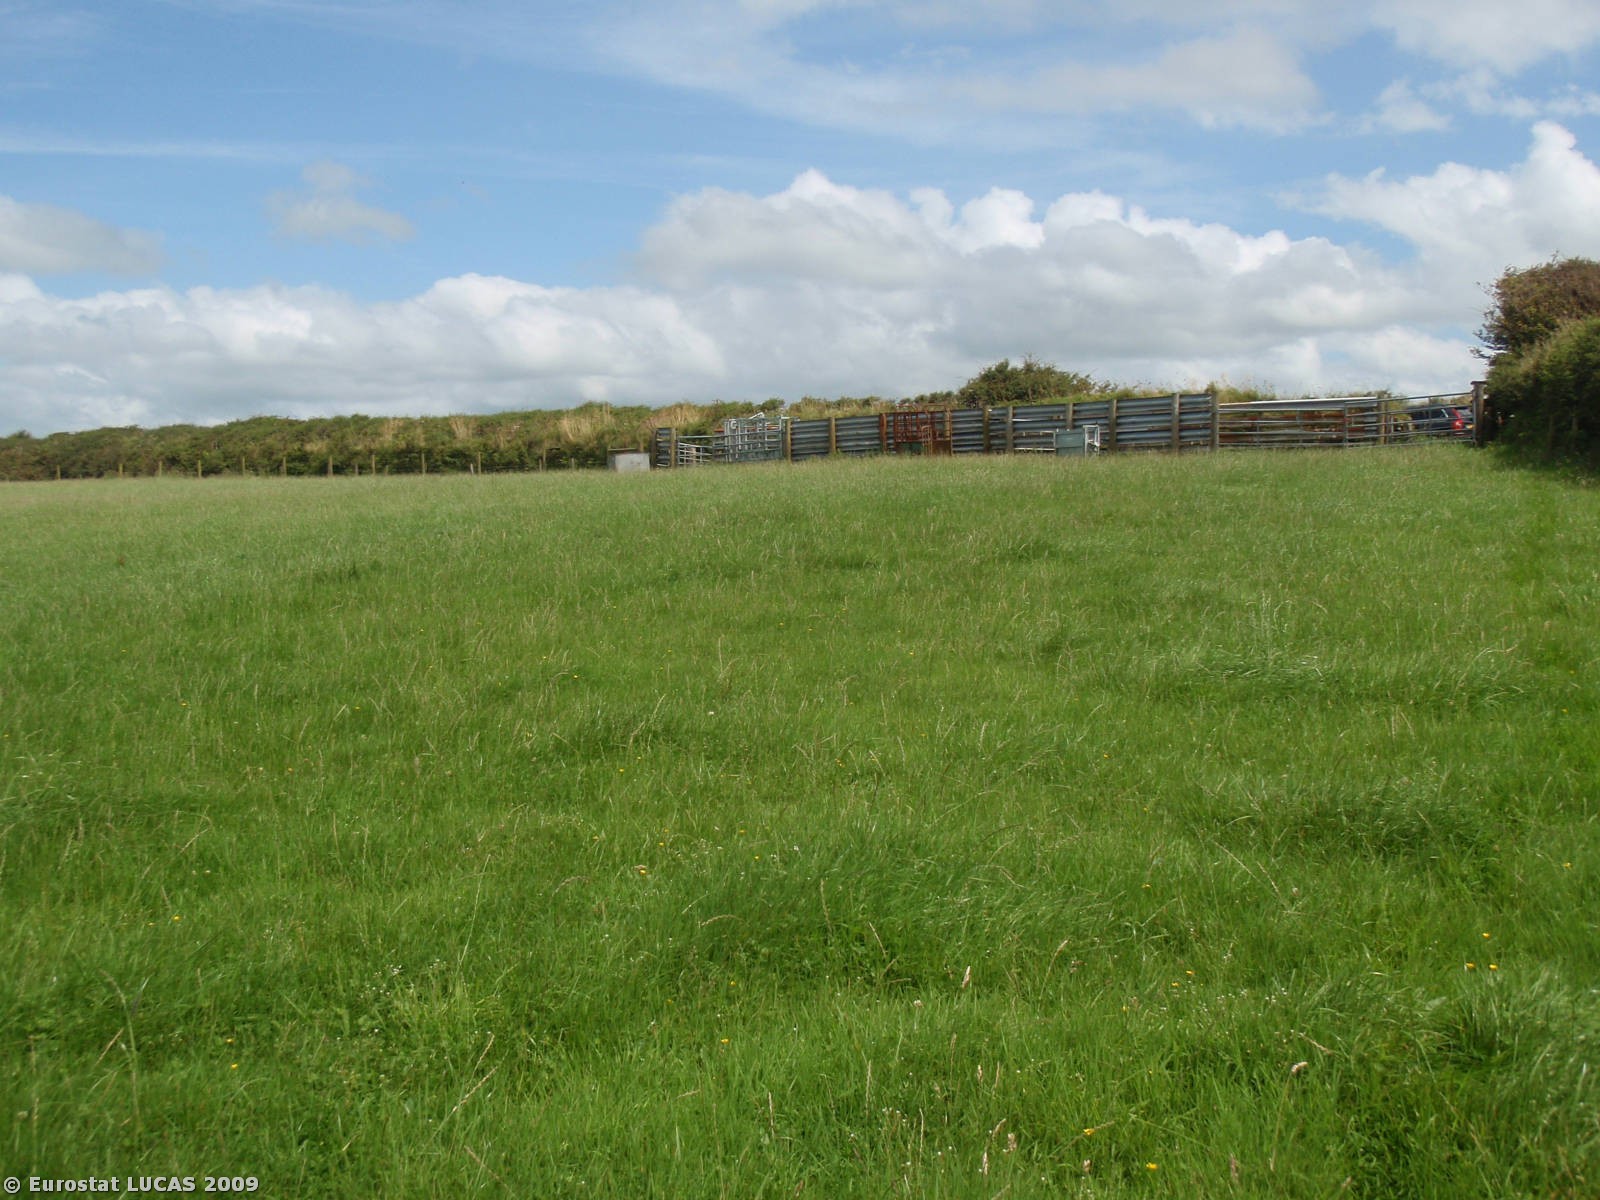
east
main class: Grassland
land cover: Grassland without tree/shrub cover
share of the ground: > 75 %
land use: Agriculture (excluding fallow land and kitchen gardens)
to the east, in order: Grassland without tree/shrub cover; Electric lines; Grassland without tree/shrub cover; Artificial constructions in urban areas; Fences; Grassland without tree/shrub cover; Managed hedges; Grass margins; Paved roads, cycling and walking lanes; Grass margins; Artificial constructions; Grassland without tree/shrub cover
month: August
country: GB
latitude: 50.6379
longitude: -4.6579
